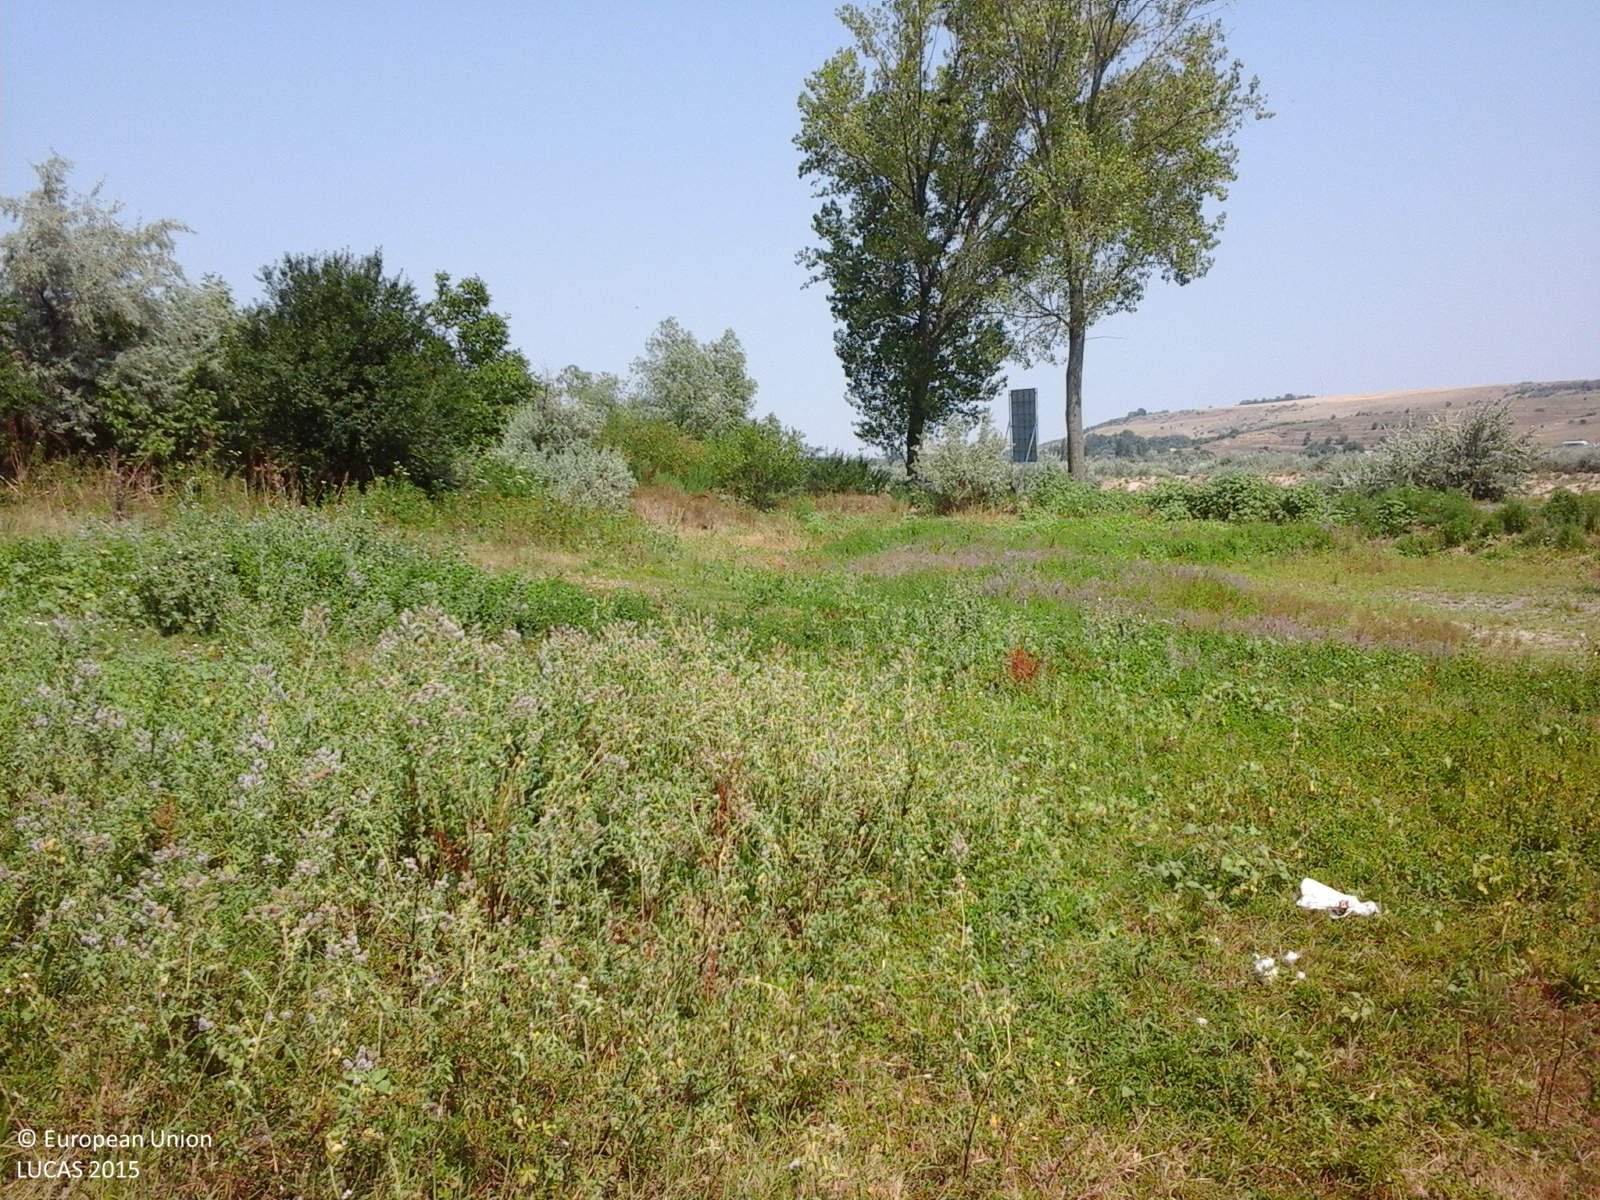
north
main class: Grassland
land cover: Grassland without tree/shrub cover
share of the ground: > 75 %
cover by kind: herbaceous plants 100 %
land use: Agriculture (excluding fallow land and kitchen gardens)
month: July
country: RO
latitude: 45.8350
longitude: 27.9234
